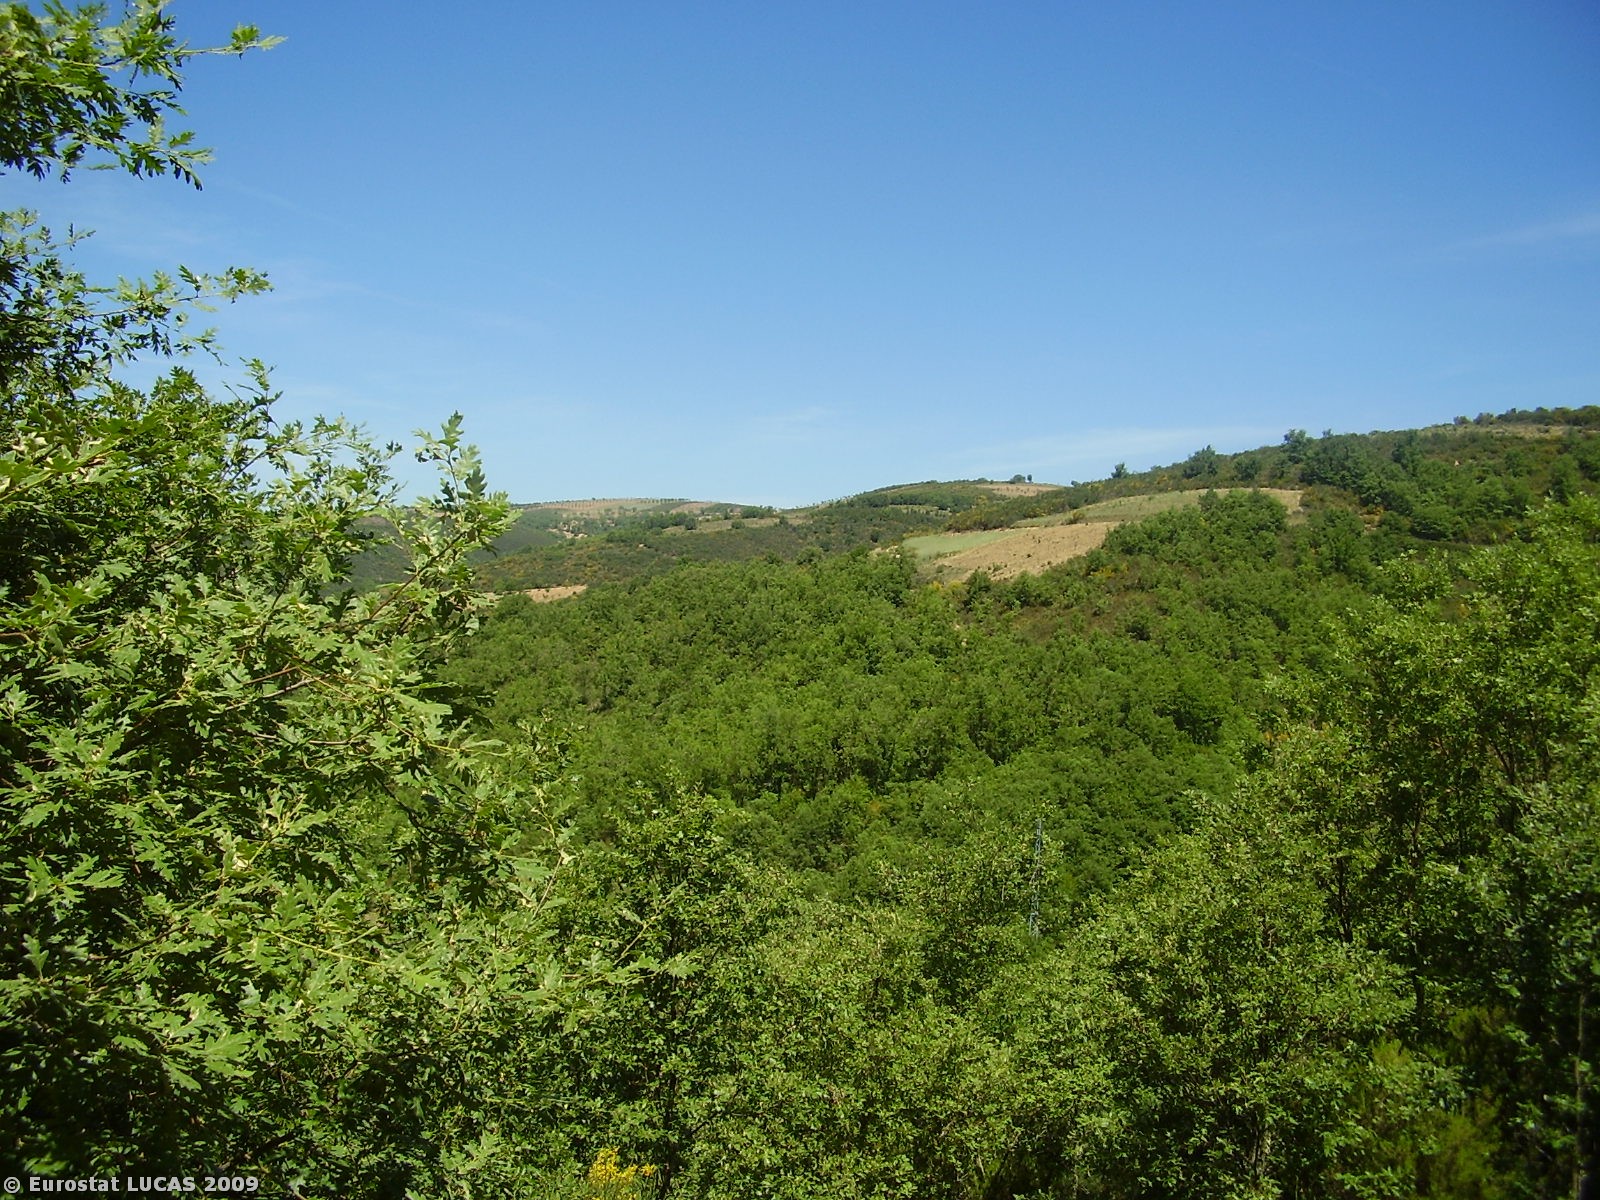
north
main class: Grassland
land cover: Grassland without tree/shrub cover
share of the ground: > 75 %
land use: Agriculture (excluding fallow land and kitchen gardens)
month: June
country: PT
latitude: 41.7177
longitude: -6.9072
